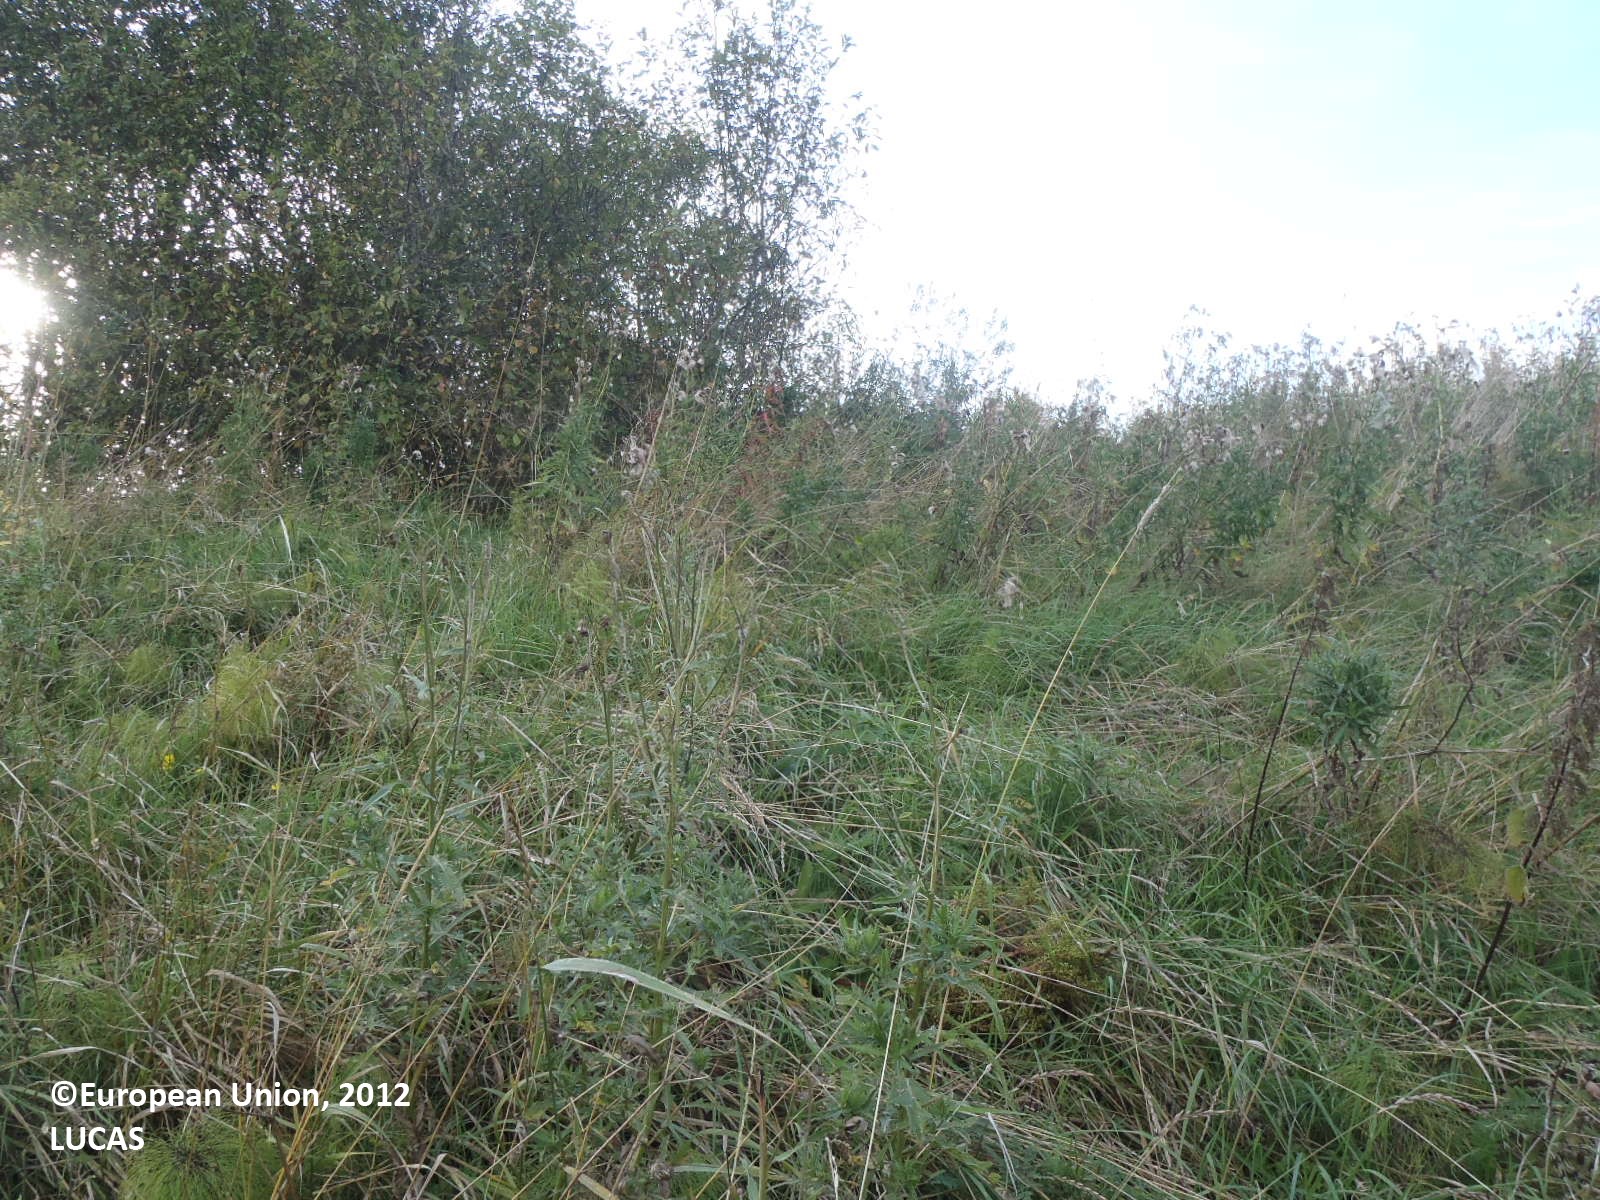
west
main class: Grassland
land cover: Grassland without tree/shrub cover
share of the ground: > 75 %
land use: Agriculture (excluding fallow land and kitchen gardens)
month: August
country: FI
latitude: 60.5352
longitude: 22.7032
